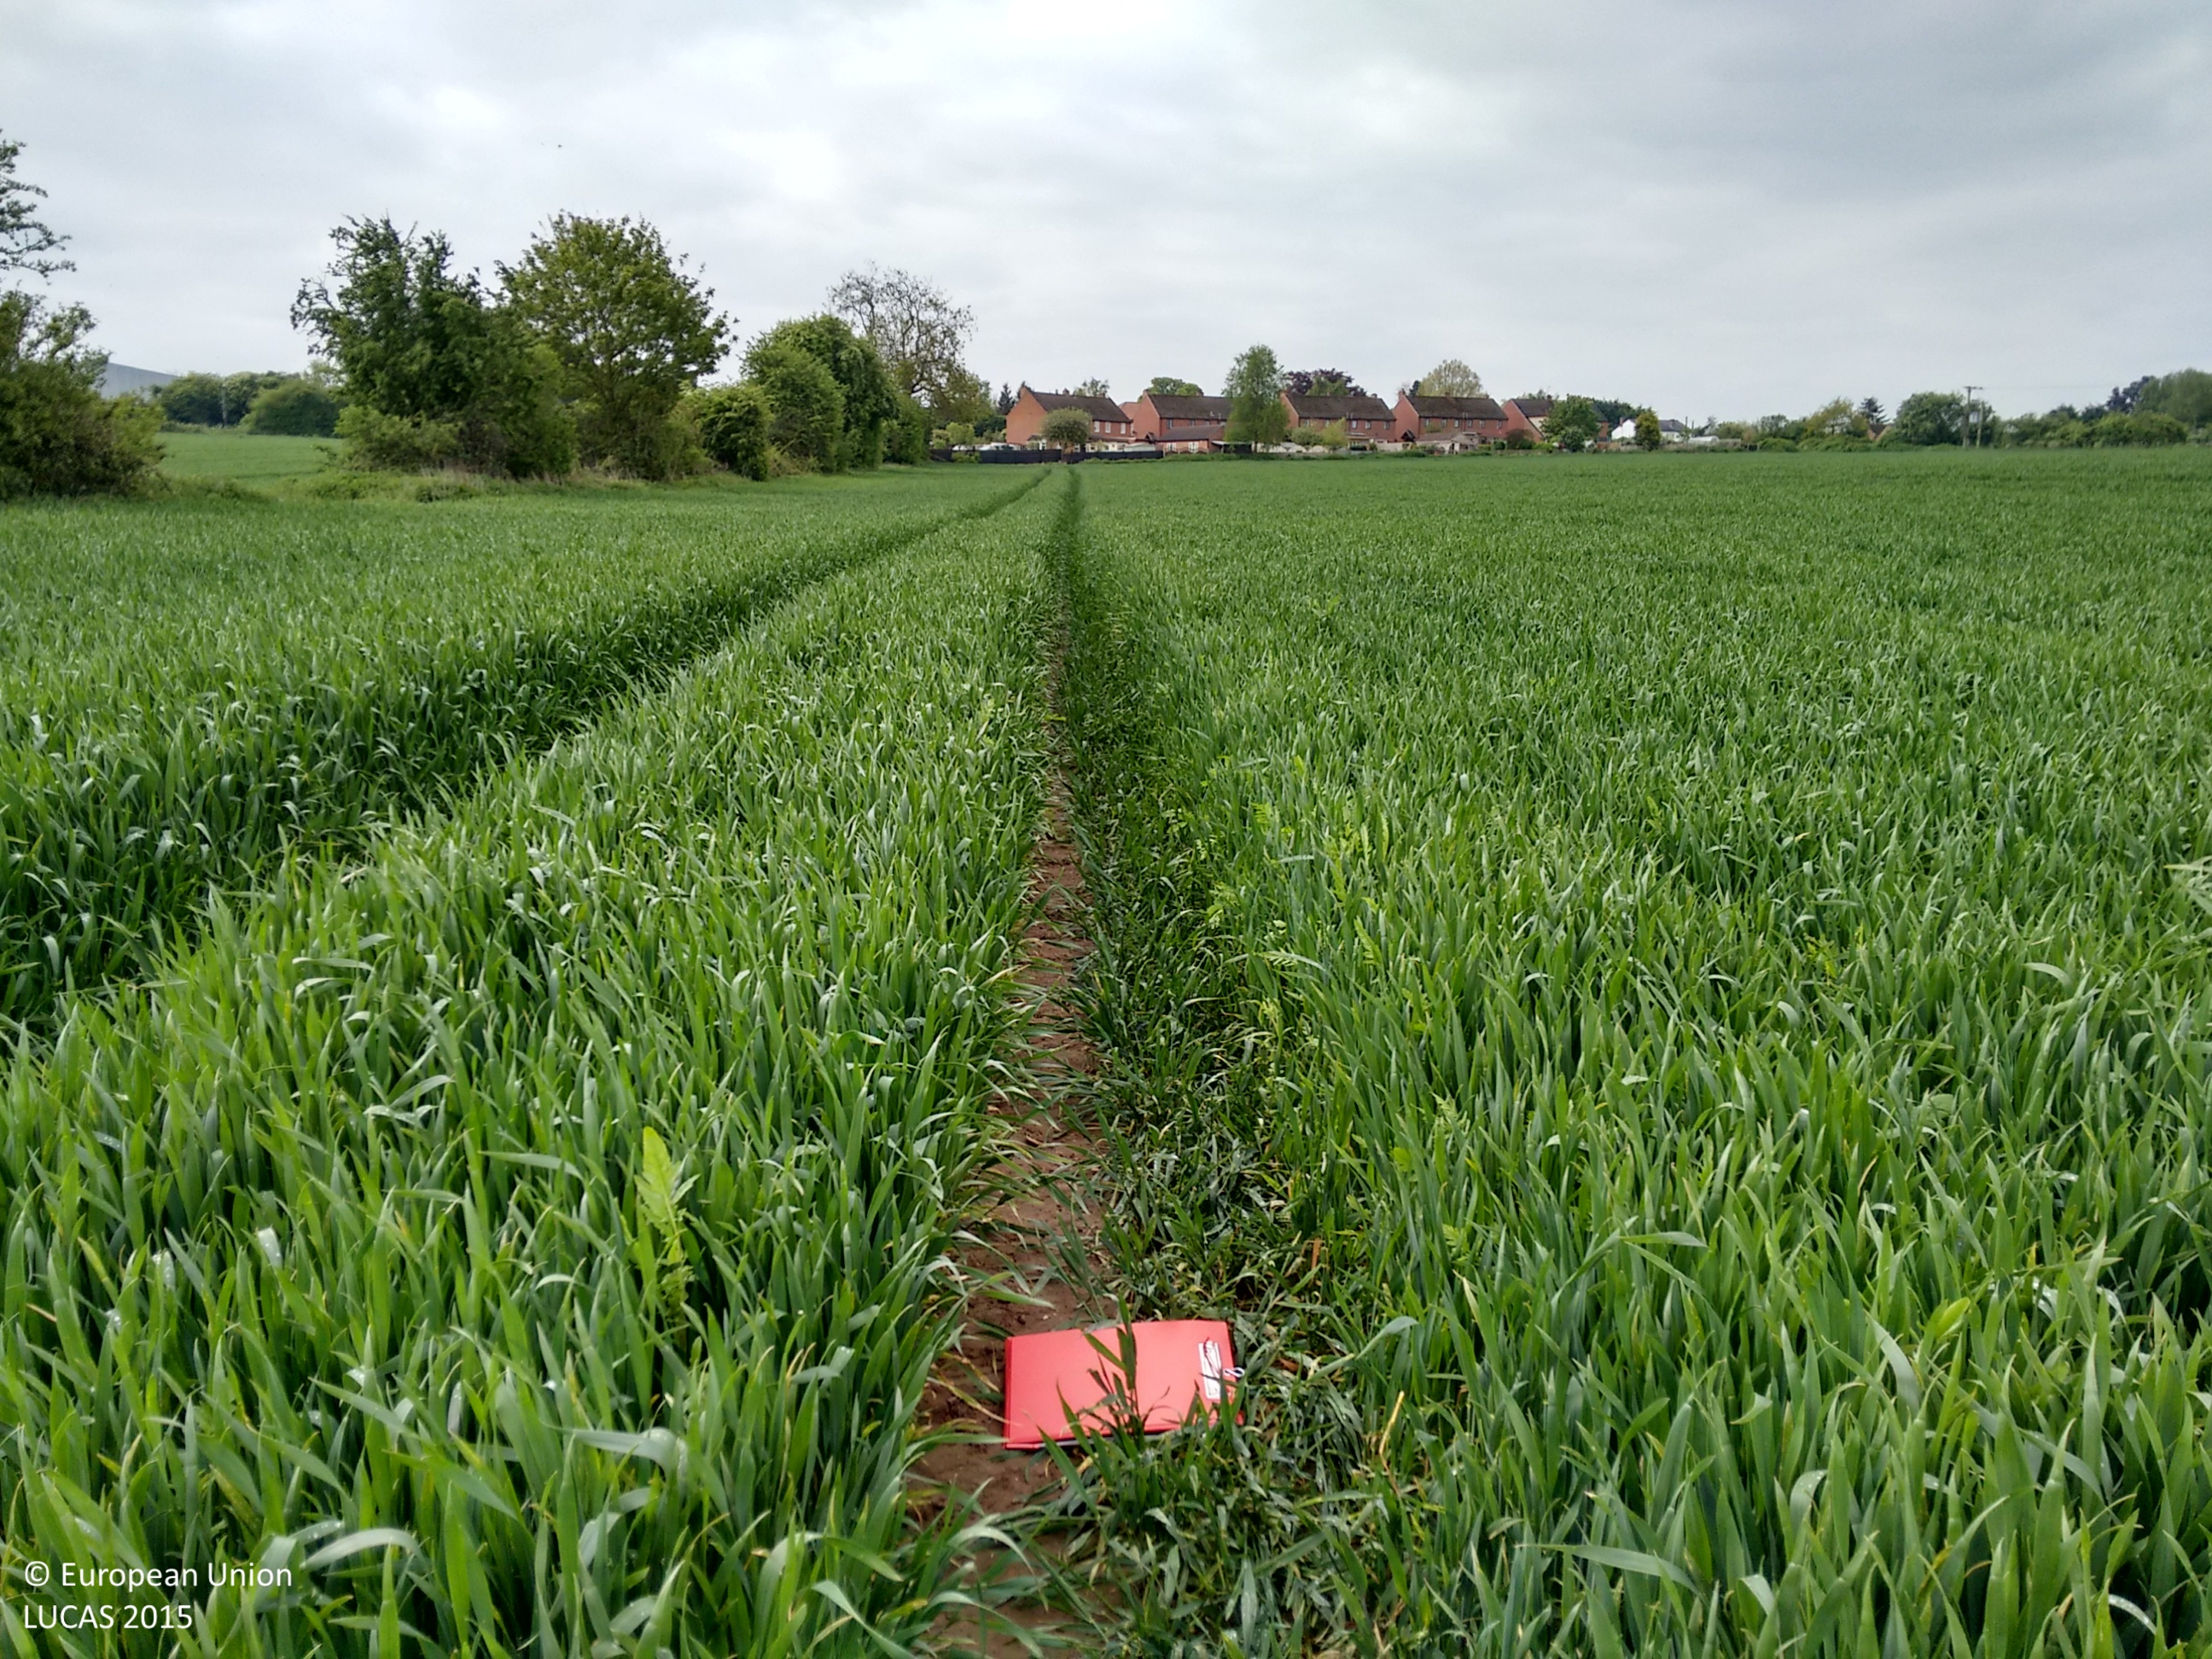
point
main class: Cropland
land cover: Common wheat
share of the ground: > 75 %
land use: Agriculture (excluding fallow land and kitchen gardens)
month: May
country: GB
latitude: 52.4352
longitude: -1.3007
